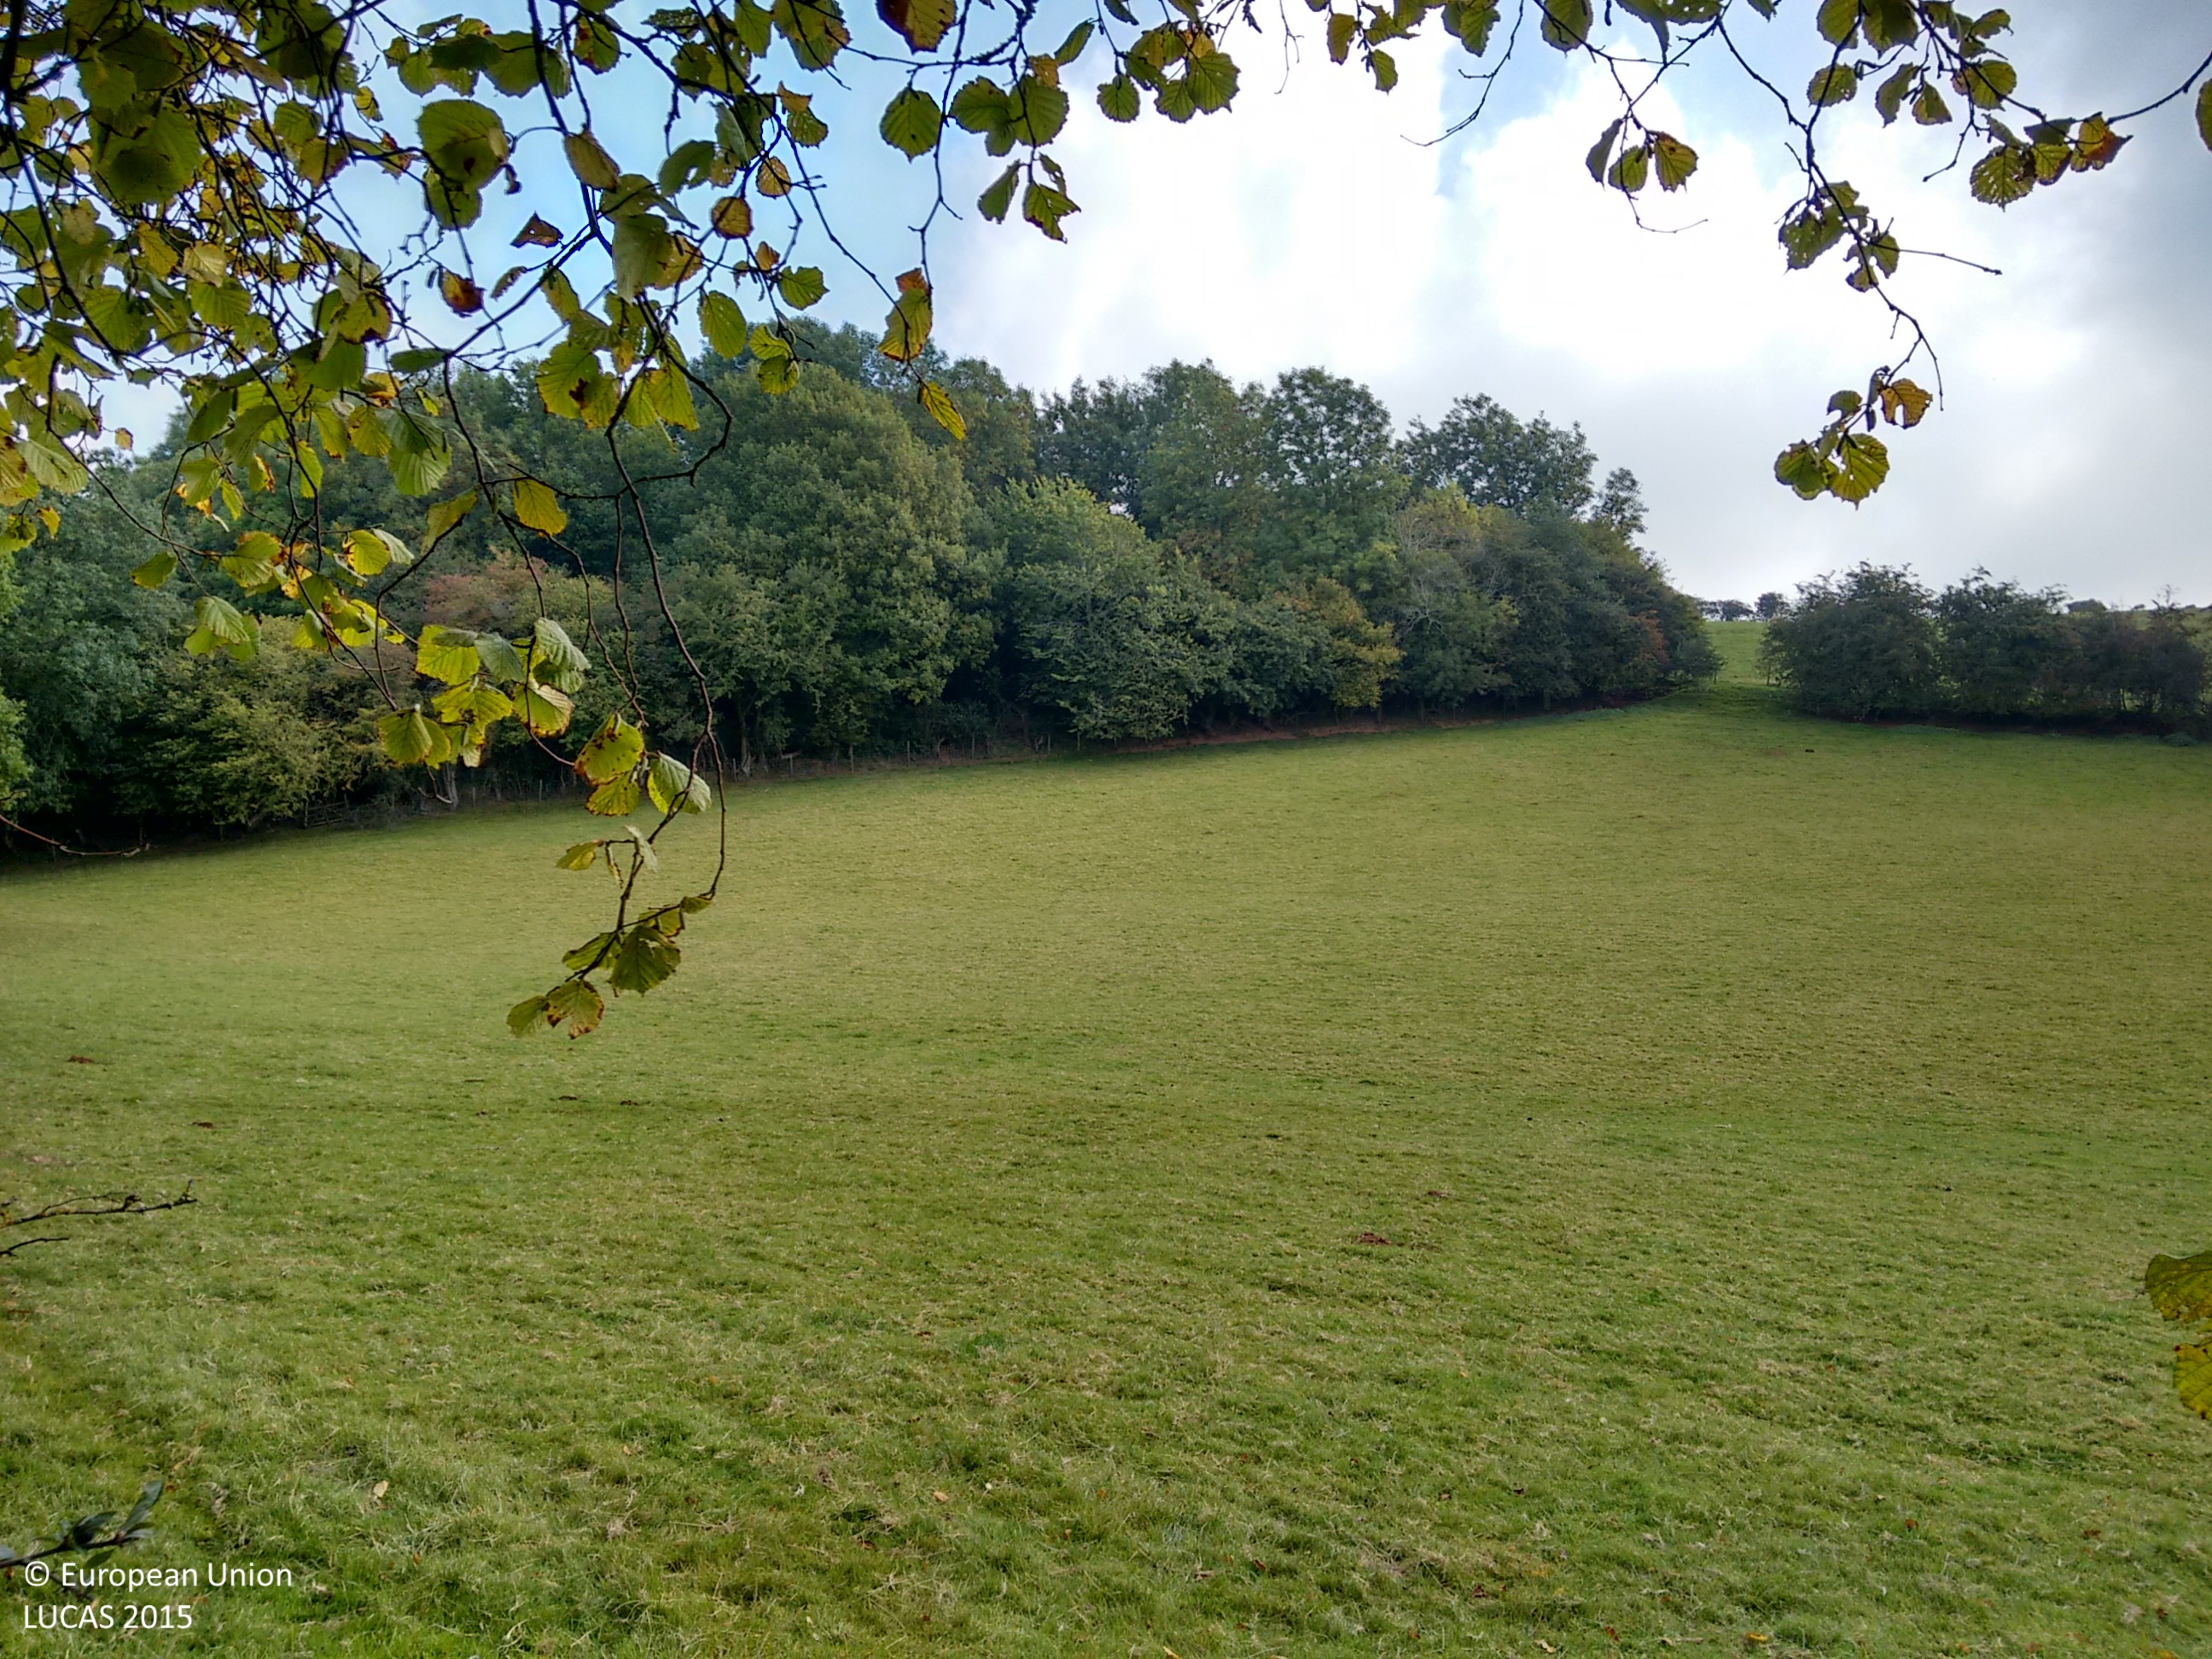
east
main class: Grassland
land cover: Grassland without tree/shrub cover
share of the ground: > 75 %
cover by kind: herbaceous plants 100 %
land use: Agriculture (excluding fallow land and kitchen gardens)
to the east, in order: Abandoned hedges; Ditches and canals; Abandoned hedges; Grassland without tree/shrub cover; Fences; Broadleaved woodland; Fences; Grassland without tree/shrub cover
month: October
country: GB
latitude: 51.6731
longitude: -2.8704
